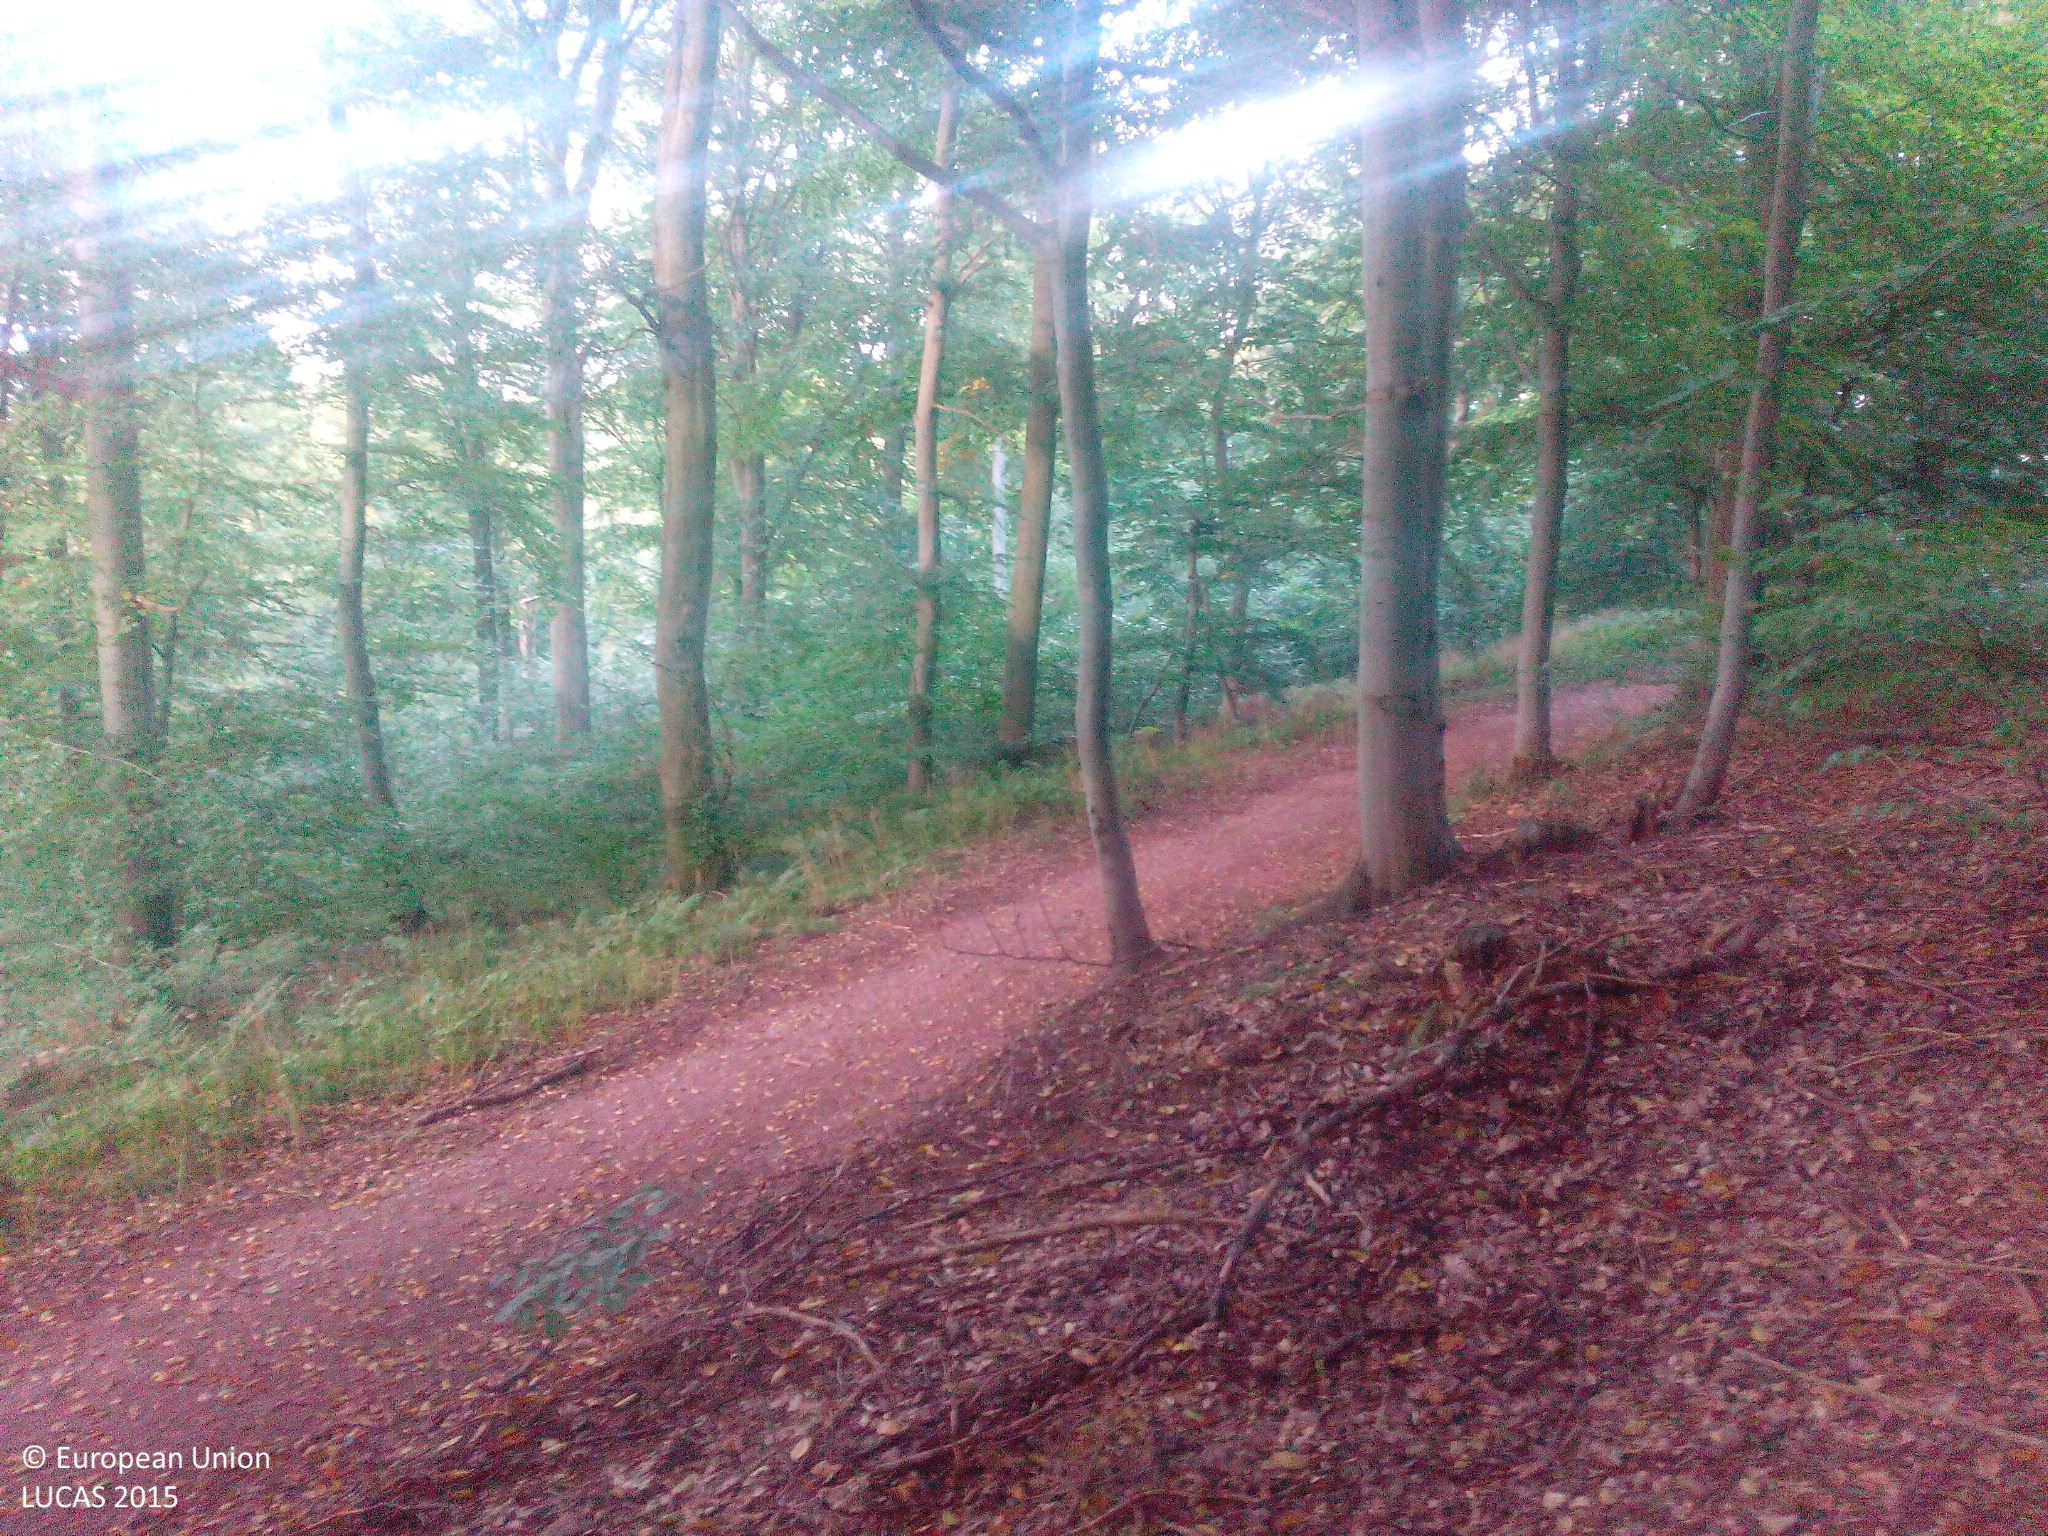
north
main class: Woodland
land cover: Spruce dominated mixed woodland
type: hemiboreal forest and nemoral coniferous forest and mixed broadleaved-coniferous forest
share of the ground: > 75 %
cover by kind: coniferous forest trees 50 %, broadleaved forest trees 50 %
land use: Forestry
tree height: > 5 m
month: September
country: DE
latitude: 51.4198
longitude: 11.0782
